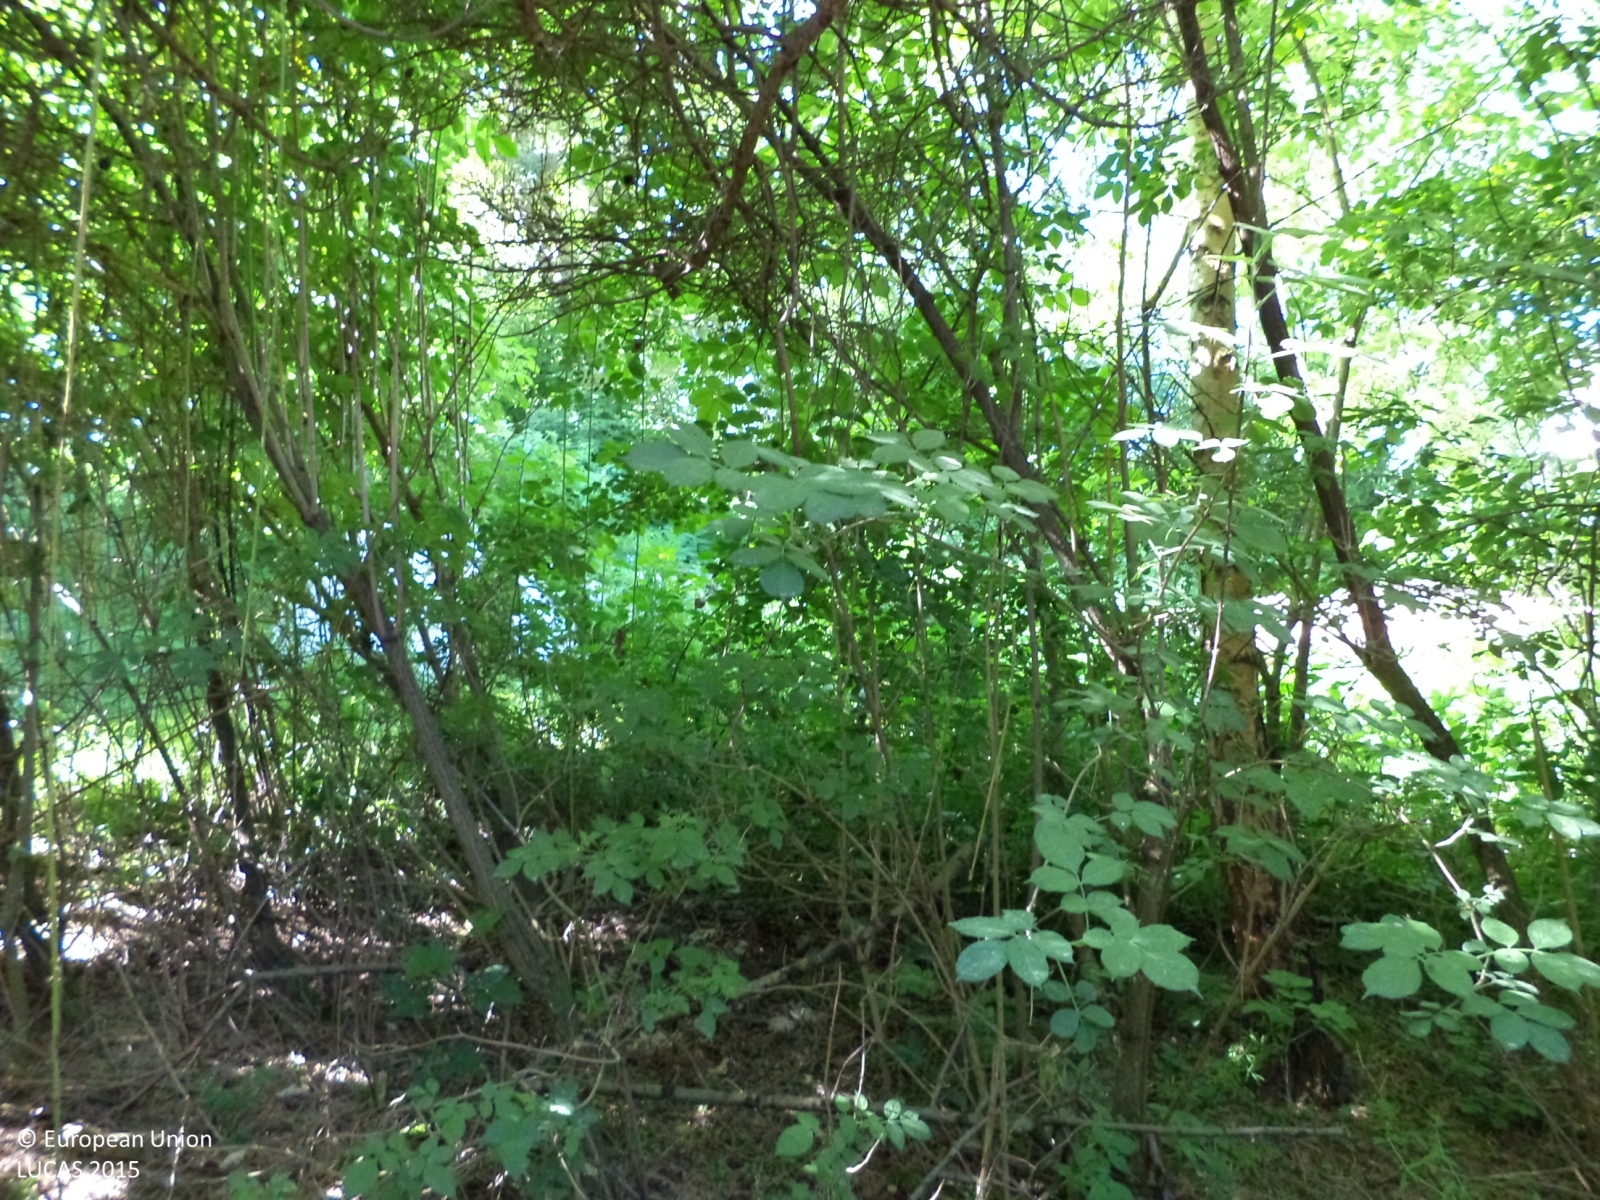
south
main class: Grassland
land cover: Spontaneously vegetated surfaces
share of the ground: > 75 %
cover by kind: herbaceous plants 95 %, shrubs 5 %
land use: Fallow land
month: June
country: CZ
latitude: 49.6445
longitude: 14.9465
